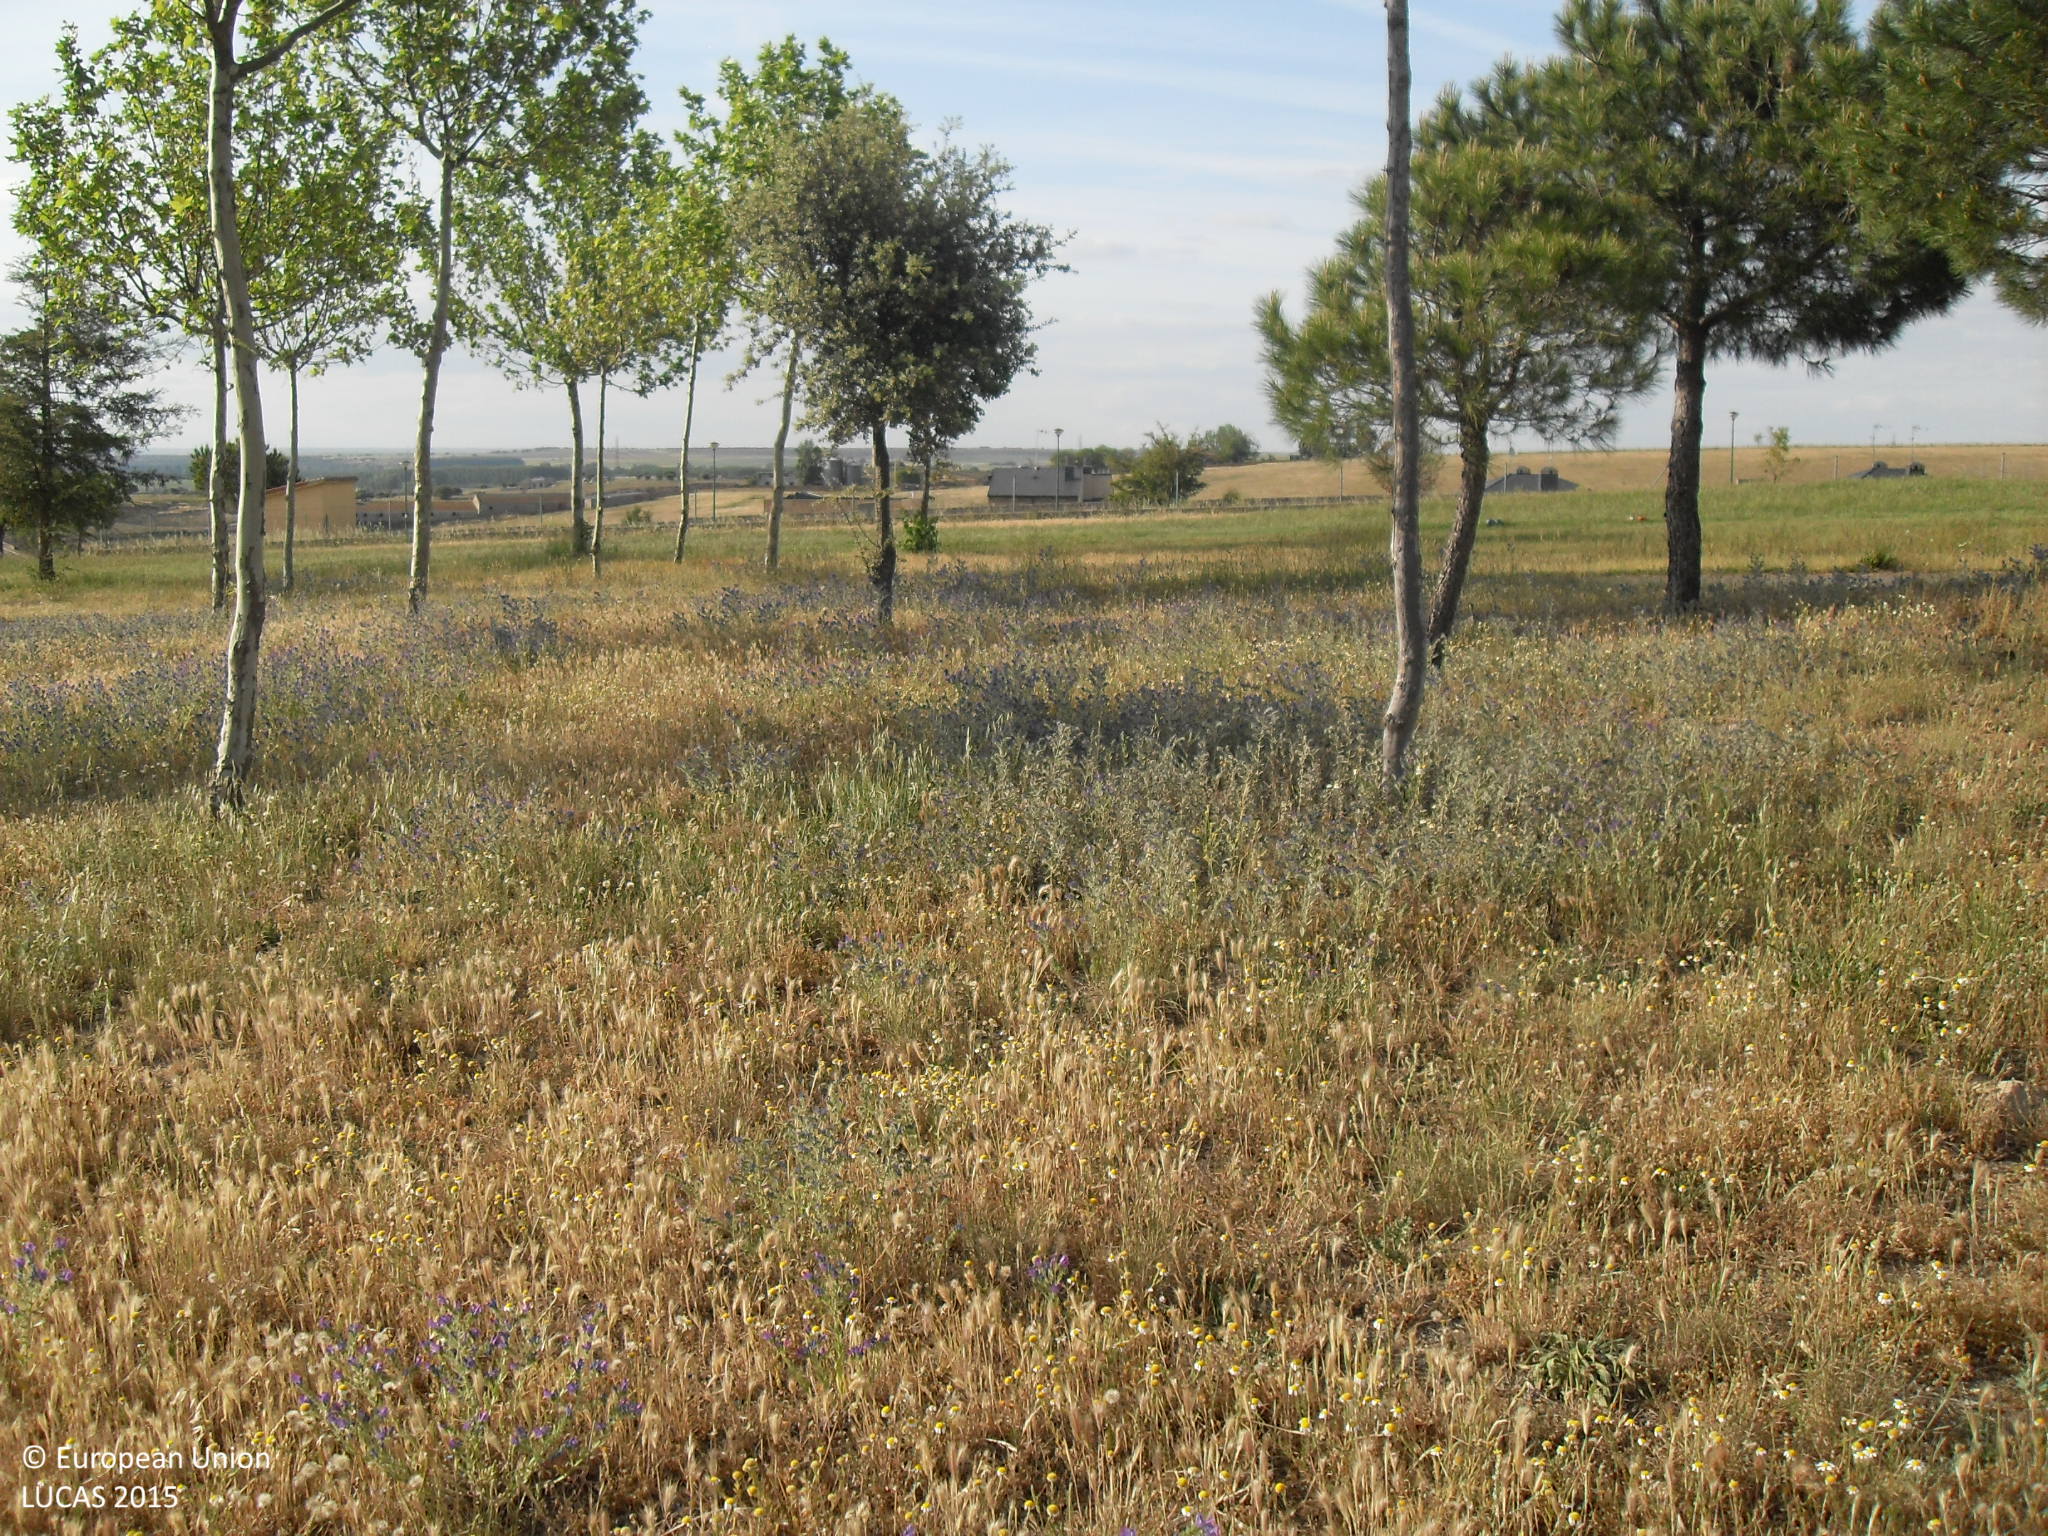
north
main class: Grassland
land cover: Grassland without tree/shrub cover
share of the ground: > 75 %
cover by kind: herbaceous plants 100 %
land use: Agriculture (excluding fallow land and kitchen gardens)
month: May
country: ES
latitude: 40.9788
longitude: -5.7066
